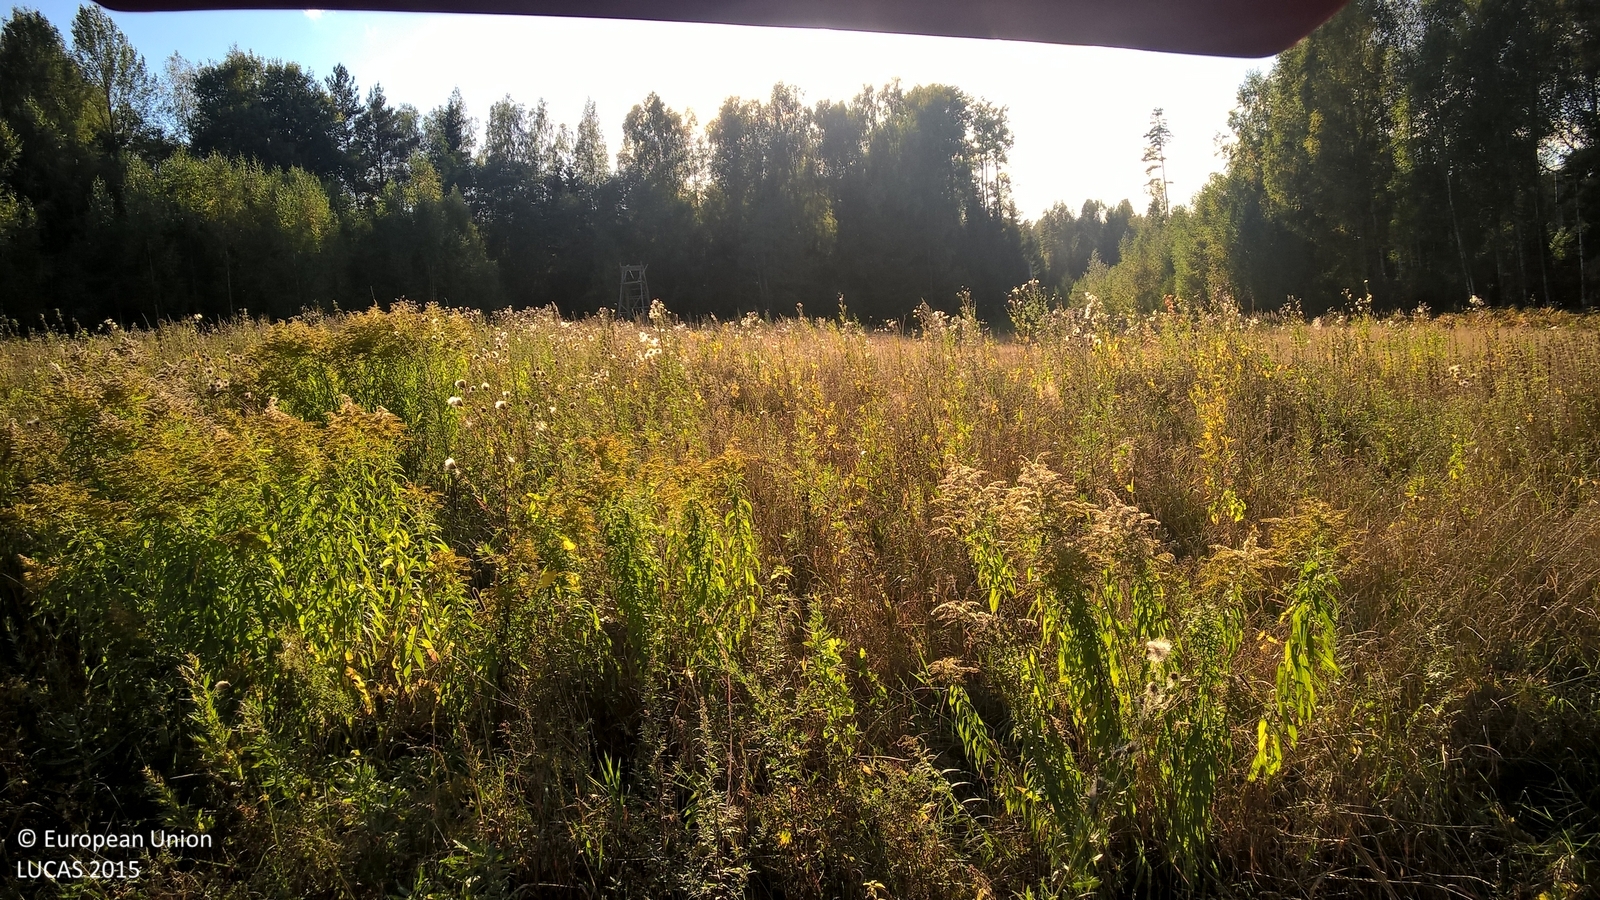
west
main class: Grassland
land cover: Spontaneously vegetated surfaces
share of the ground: > 75 %
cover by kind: herbaceous plants 100 %
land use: Fallow land
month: September
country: LV
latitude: 57.6046
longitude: 25.6657
